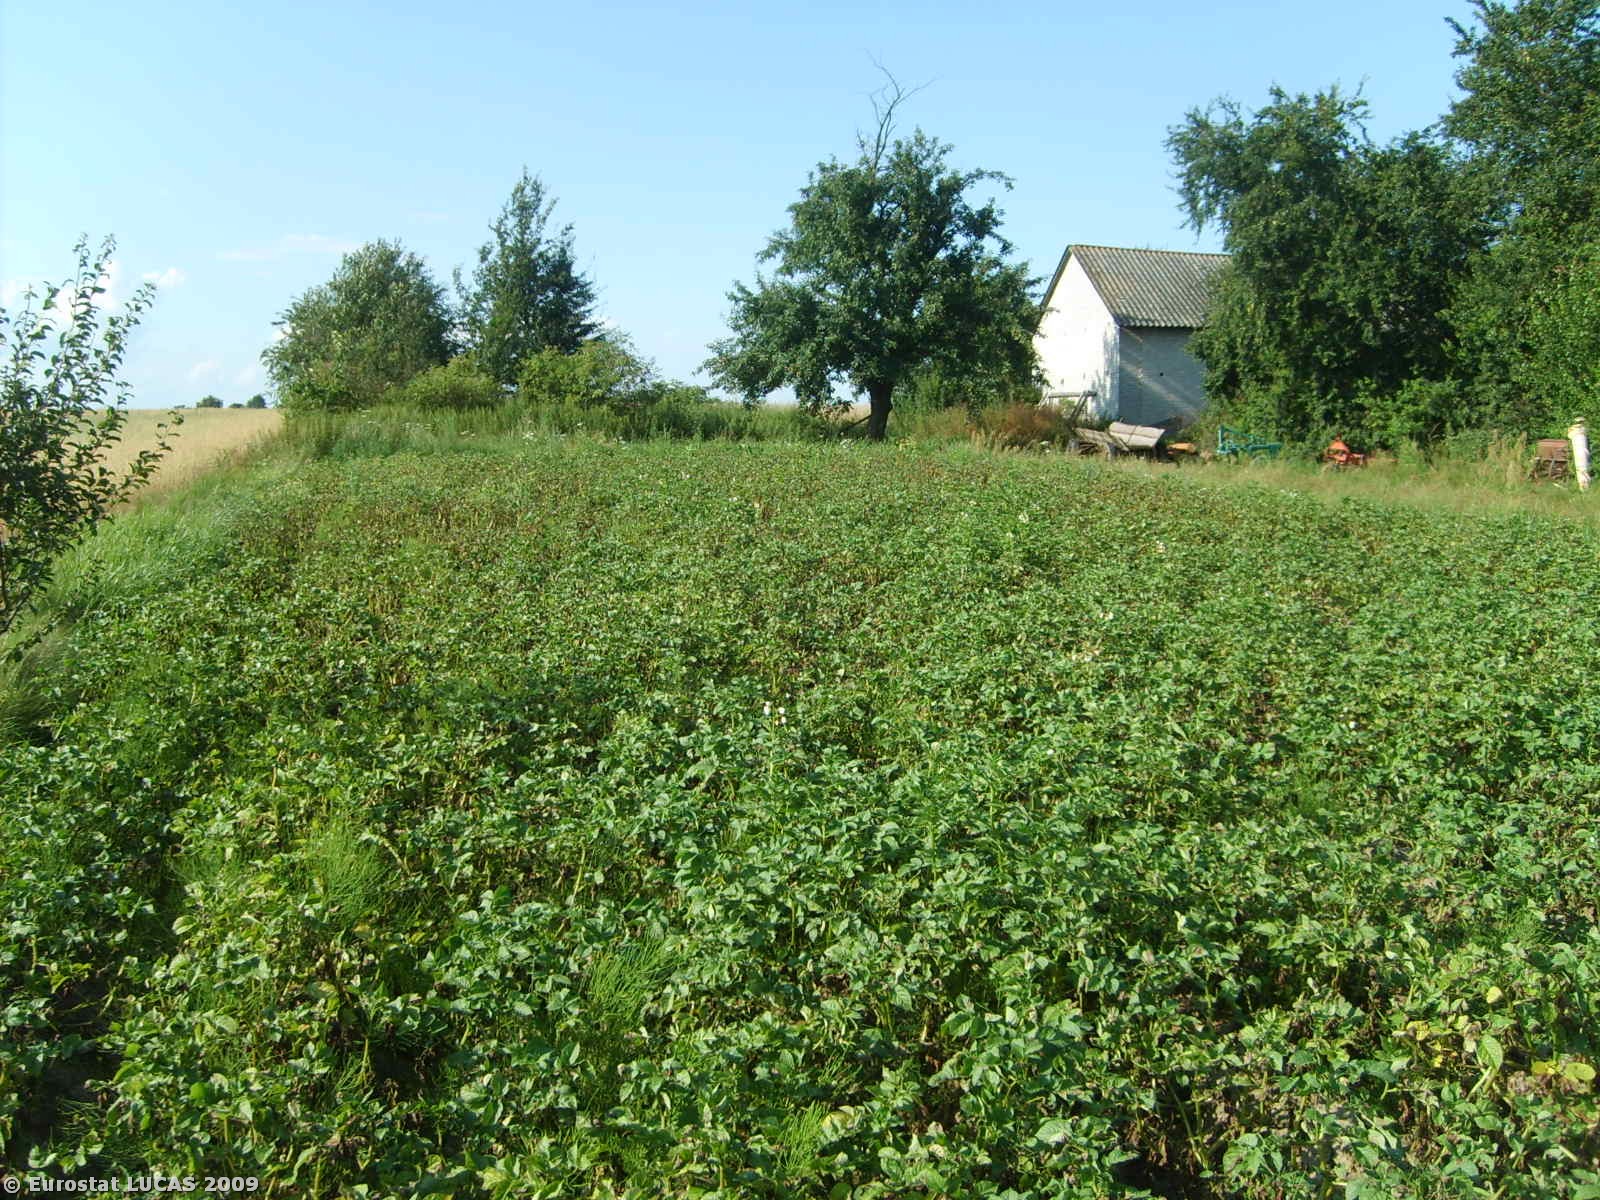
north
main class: Cropland
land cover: Potatoes
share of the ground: 50 - 75 %
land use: Agriculture (excluding fallow land and kitchen gardens)
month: July
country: PL
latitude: 51.5996
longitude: 22.0272
